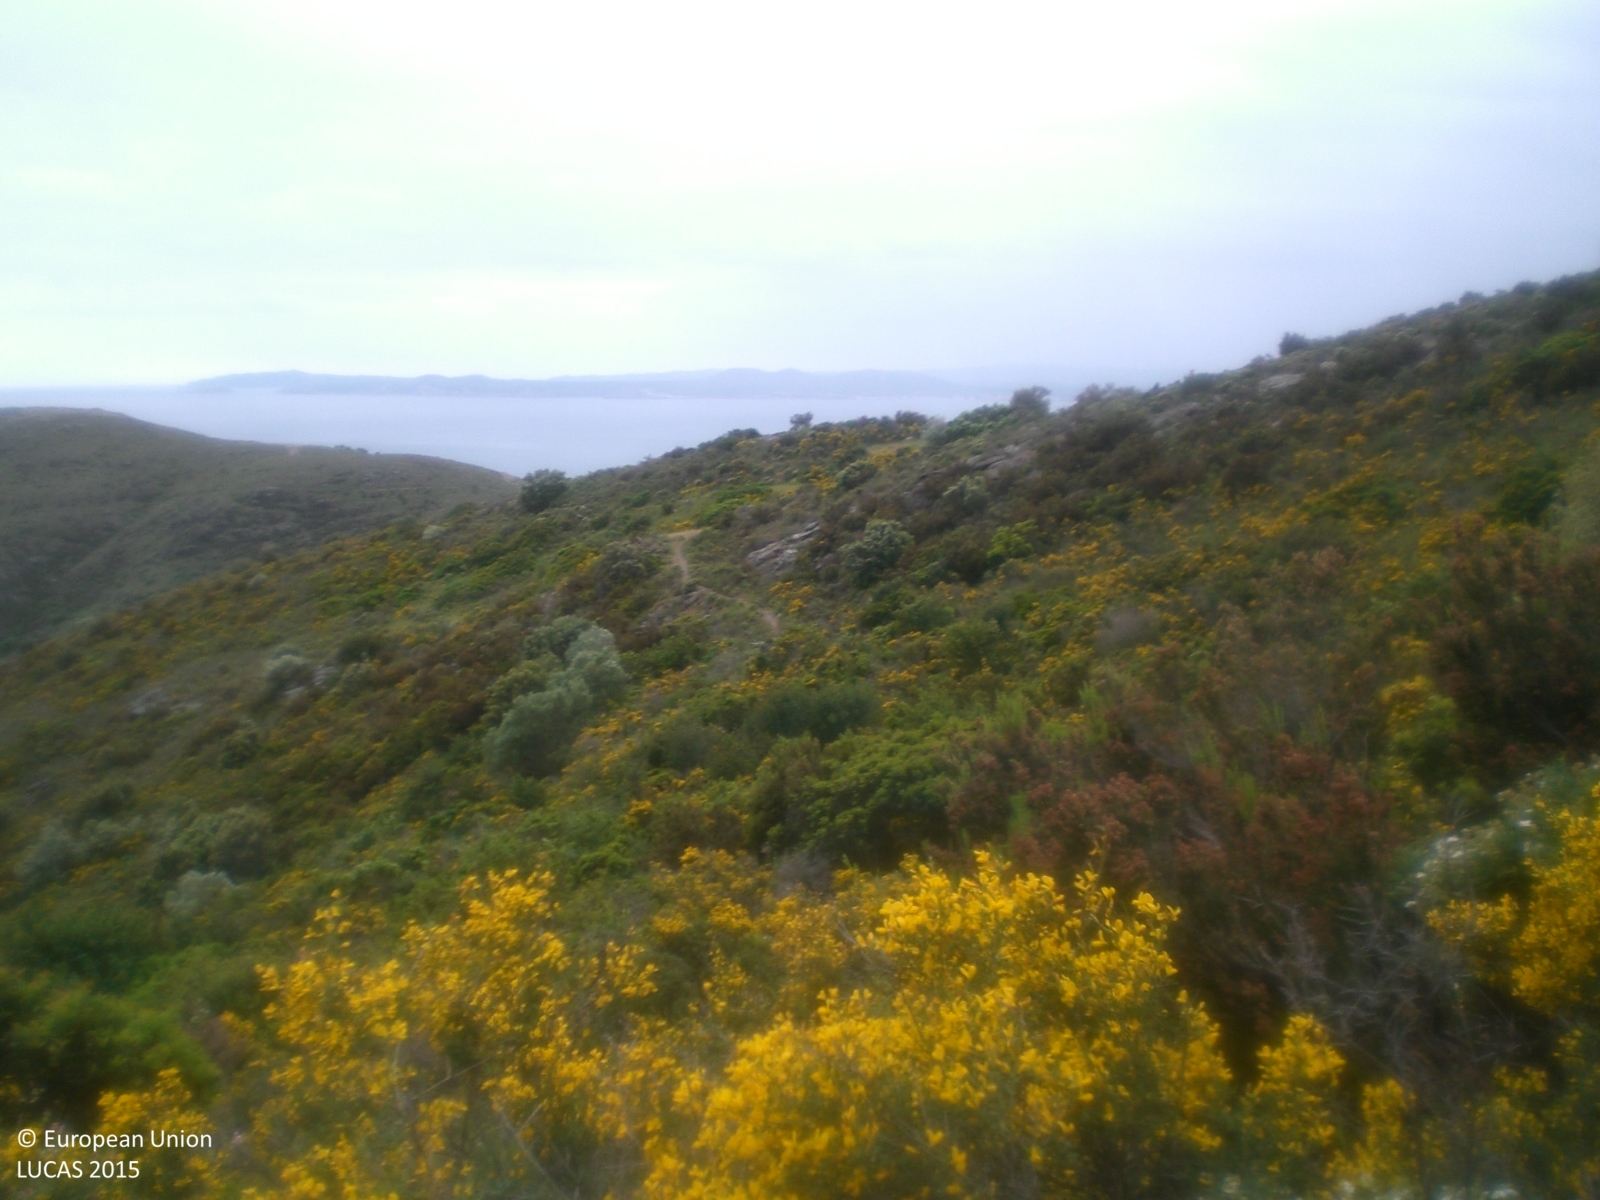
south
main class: Shrubland
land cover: Shrubland with sparse tree cover
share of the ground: > 75 %
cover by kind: shrubs 95 %, broadleaved forest trees 5 %
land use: Semi-natural and natural areas not in use
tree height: < 5 m
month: May
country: ES
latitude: 42.2632
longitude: 3.2136
